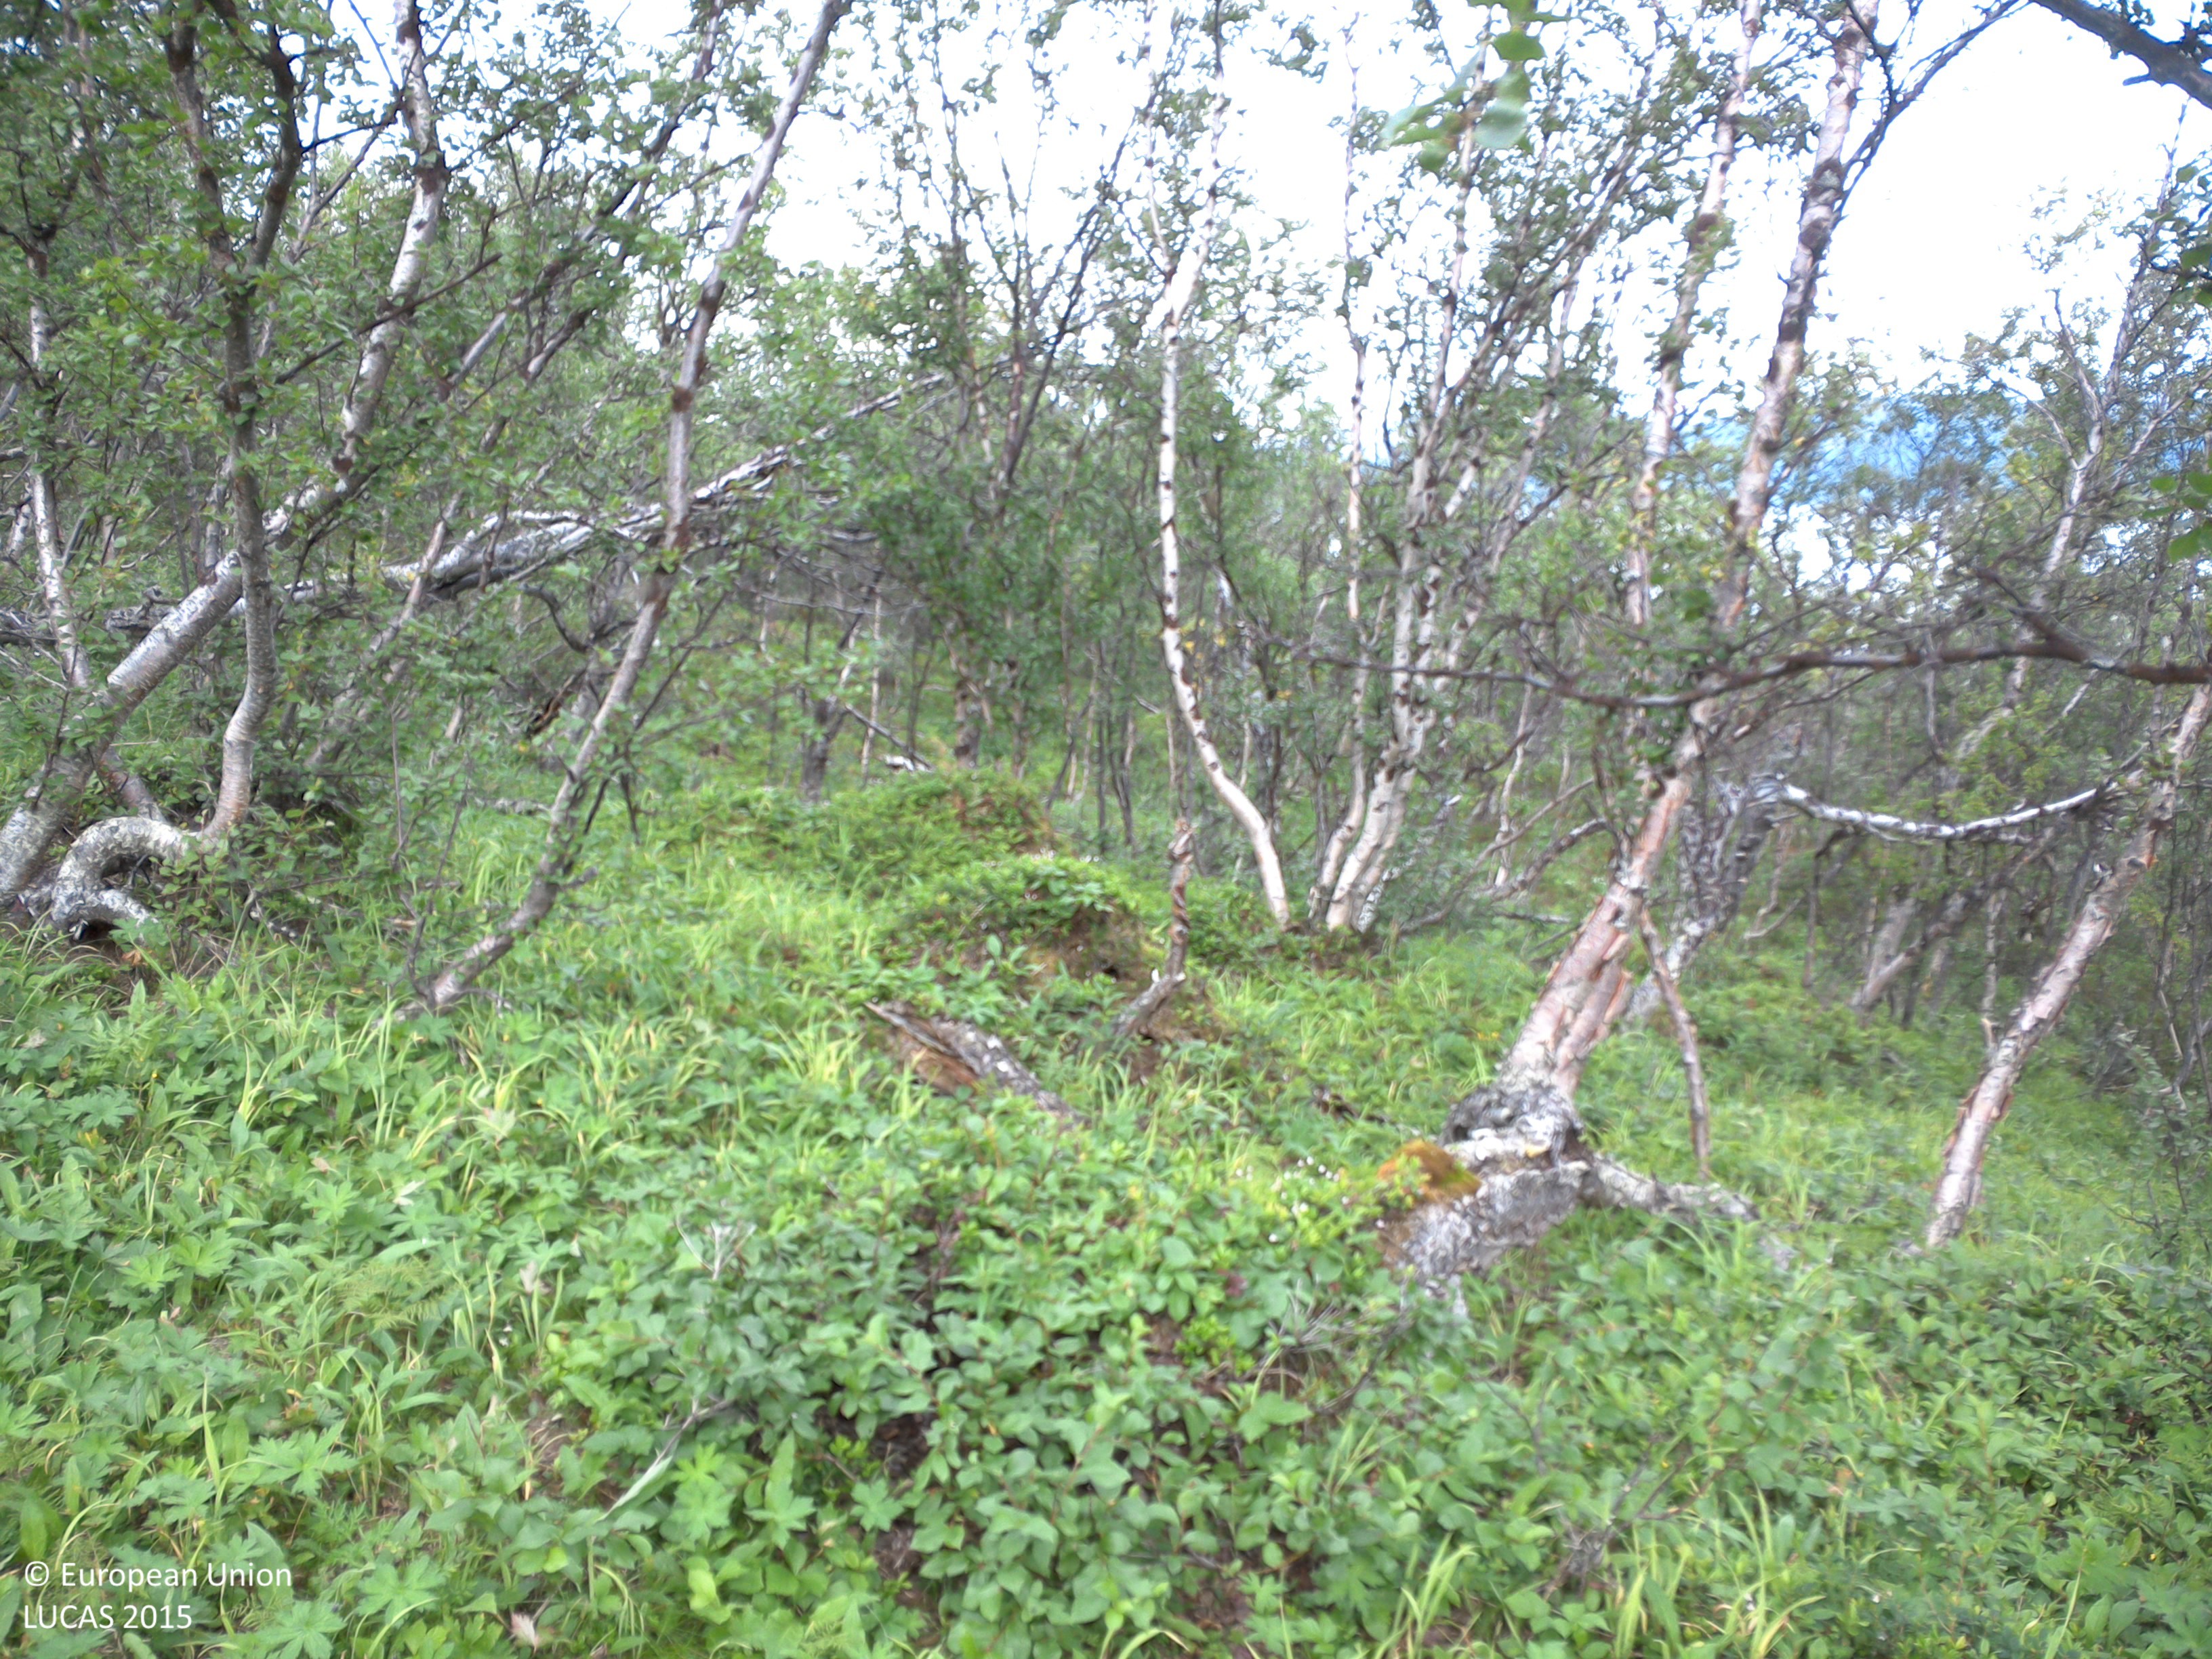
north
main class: Woodland
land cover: Broadleaved woodland
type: boreal forest
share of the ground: 25 - 50 %
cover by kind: shrubs 50 %, broadleaved forest trees 25 %, herbaceous plants 20 %, lichens and mosses 5 %
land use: Amenities, museums, leisure
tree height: > 5 m
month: August
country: SE
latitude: 68.3664
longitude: 18.7549
